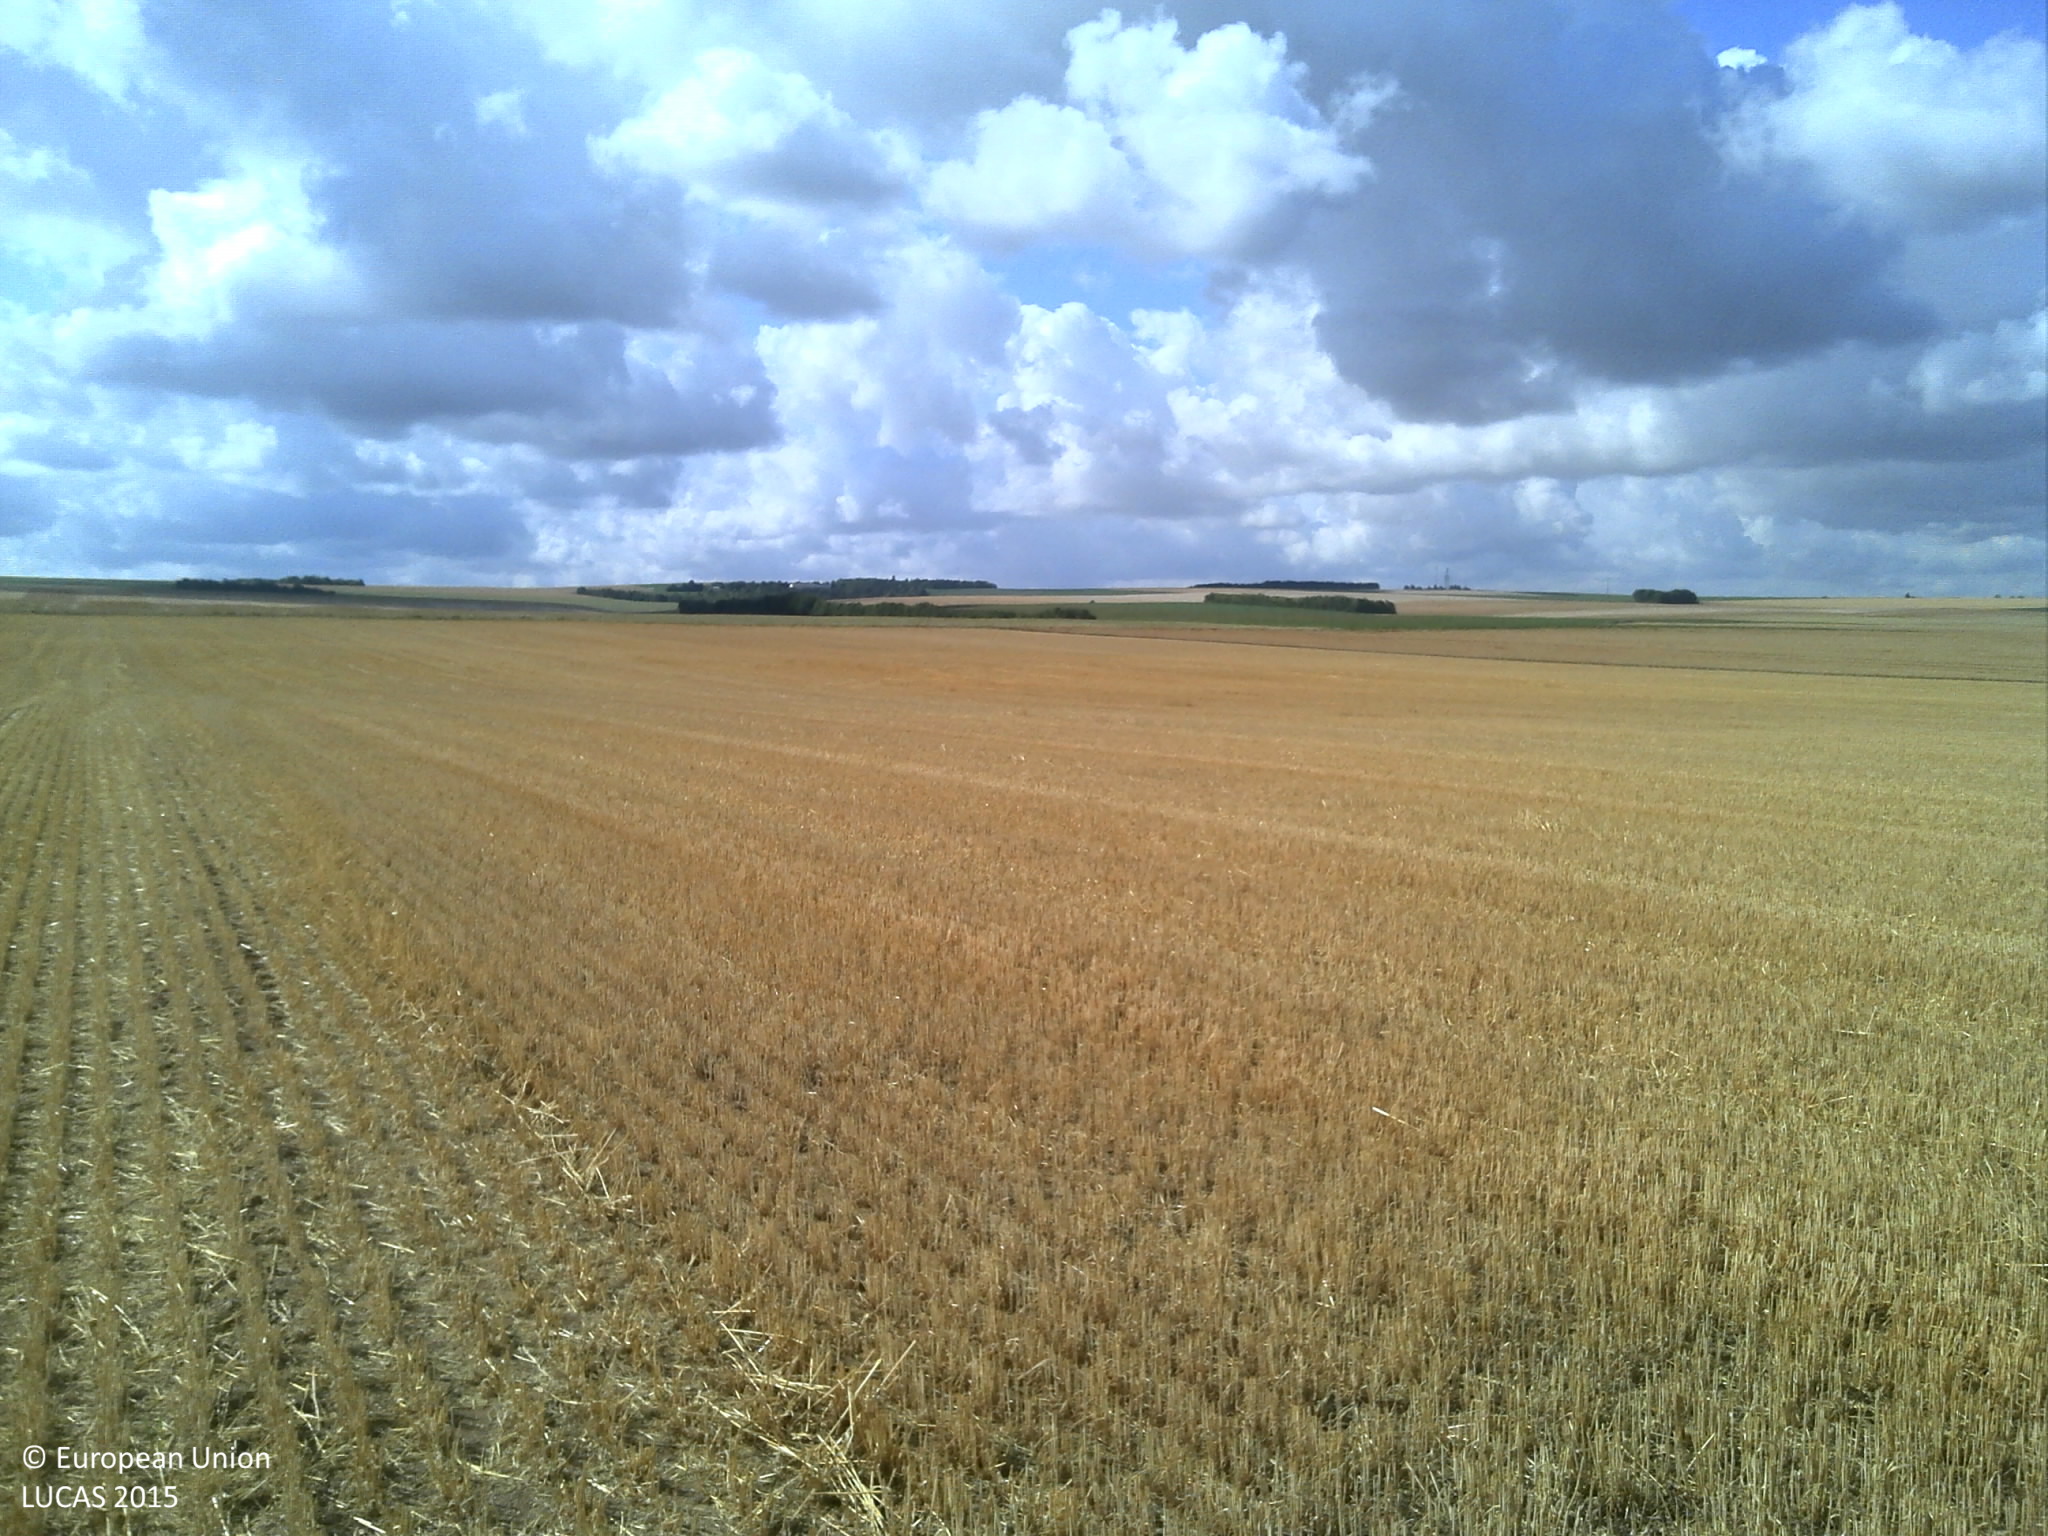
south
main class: Cropland
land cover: Barley
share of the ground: 50 - 75 %
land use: Agriculture (excluding fallow land and kitchen gardens)
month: July
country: FR
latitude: 49.3142
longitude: 4.5354
